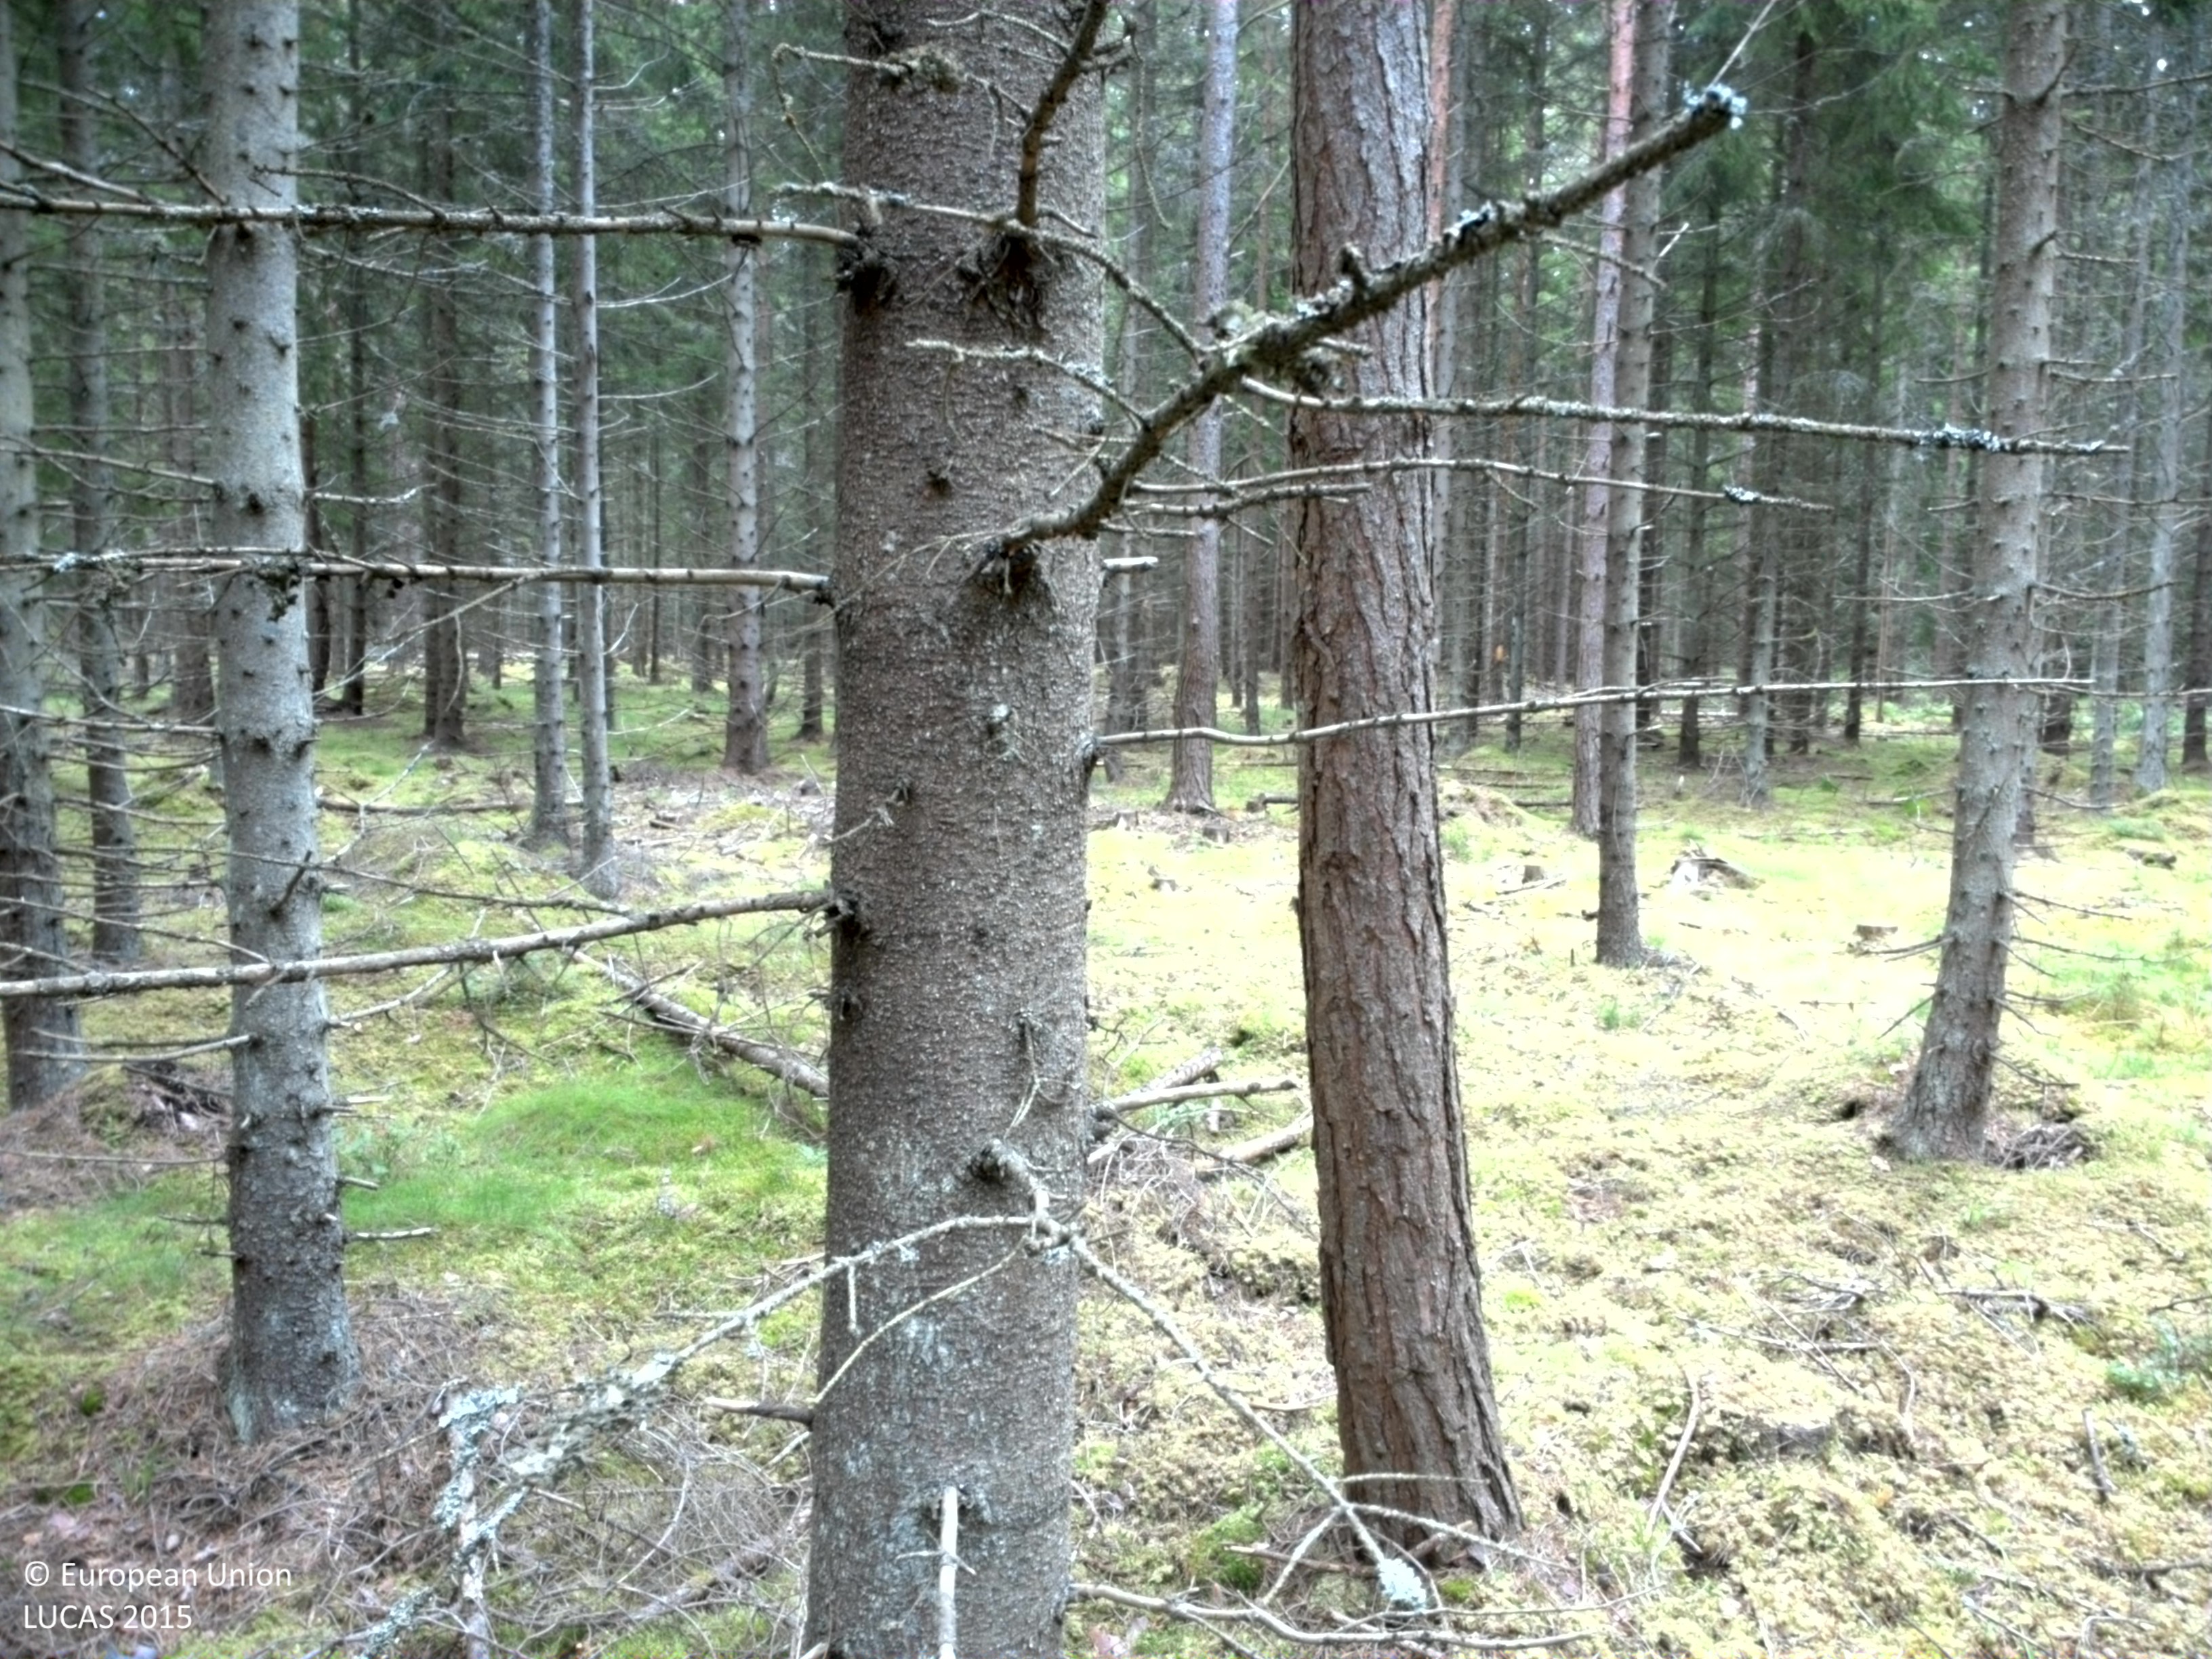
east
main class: Woodland
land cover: Spruce dominated coniferous woodland
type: boreal forest
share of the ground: 50 - 75 %
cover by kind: coniferous forest trees 75 %, lichens and mosses 25 %
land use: Forestry
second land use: Amenities, museums, leisure
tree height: > 5 m
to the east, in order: Spruce dominated coniferous woodland; Tracks; Spruce dominated coniferous woodland; Tracks; Pine dominated coniferous woodland; Tracks; Pine dominated coniferous woodland
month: July
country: SE
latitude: 58.6270
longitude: 13.3864
